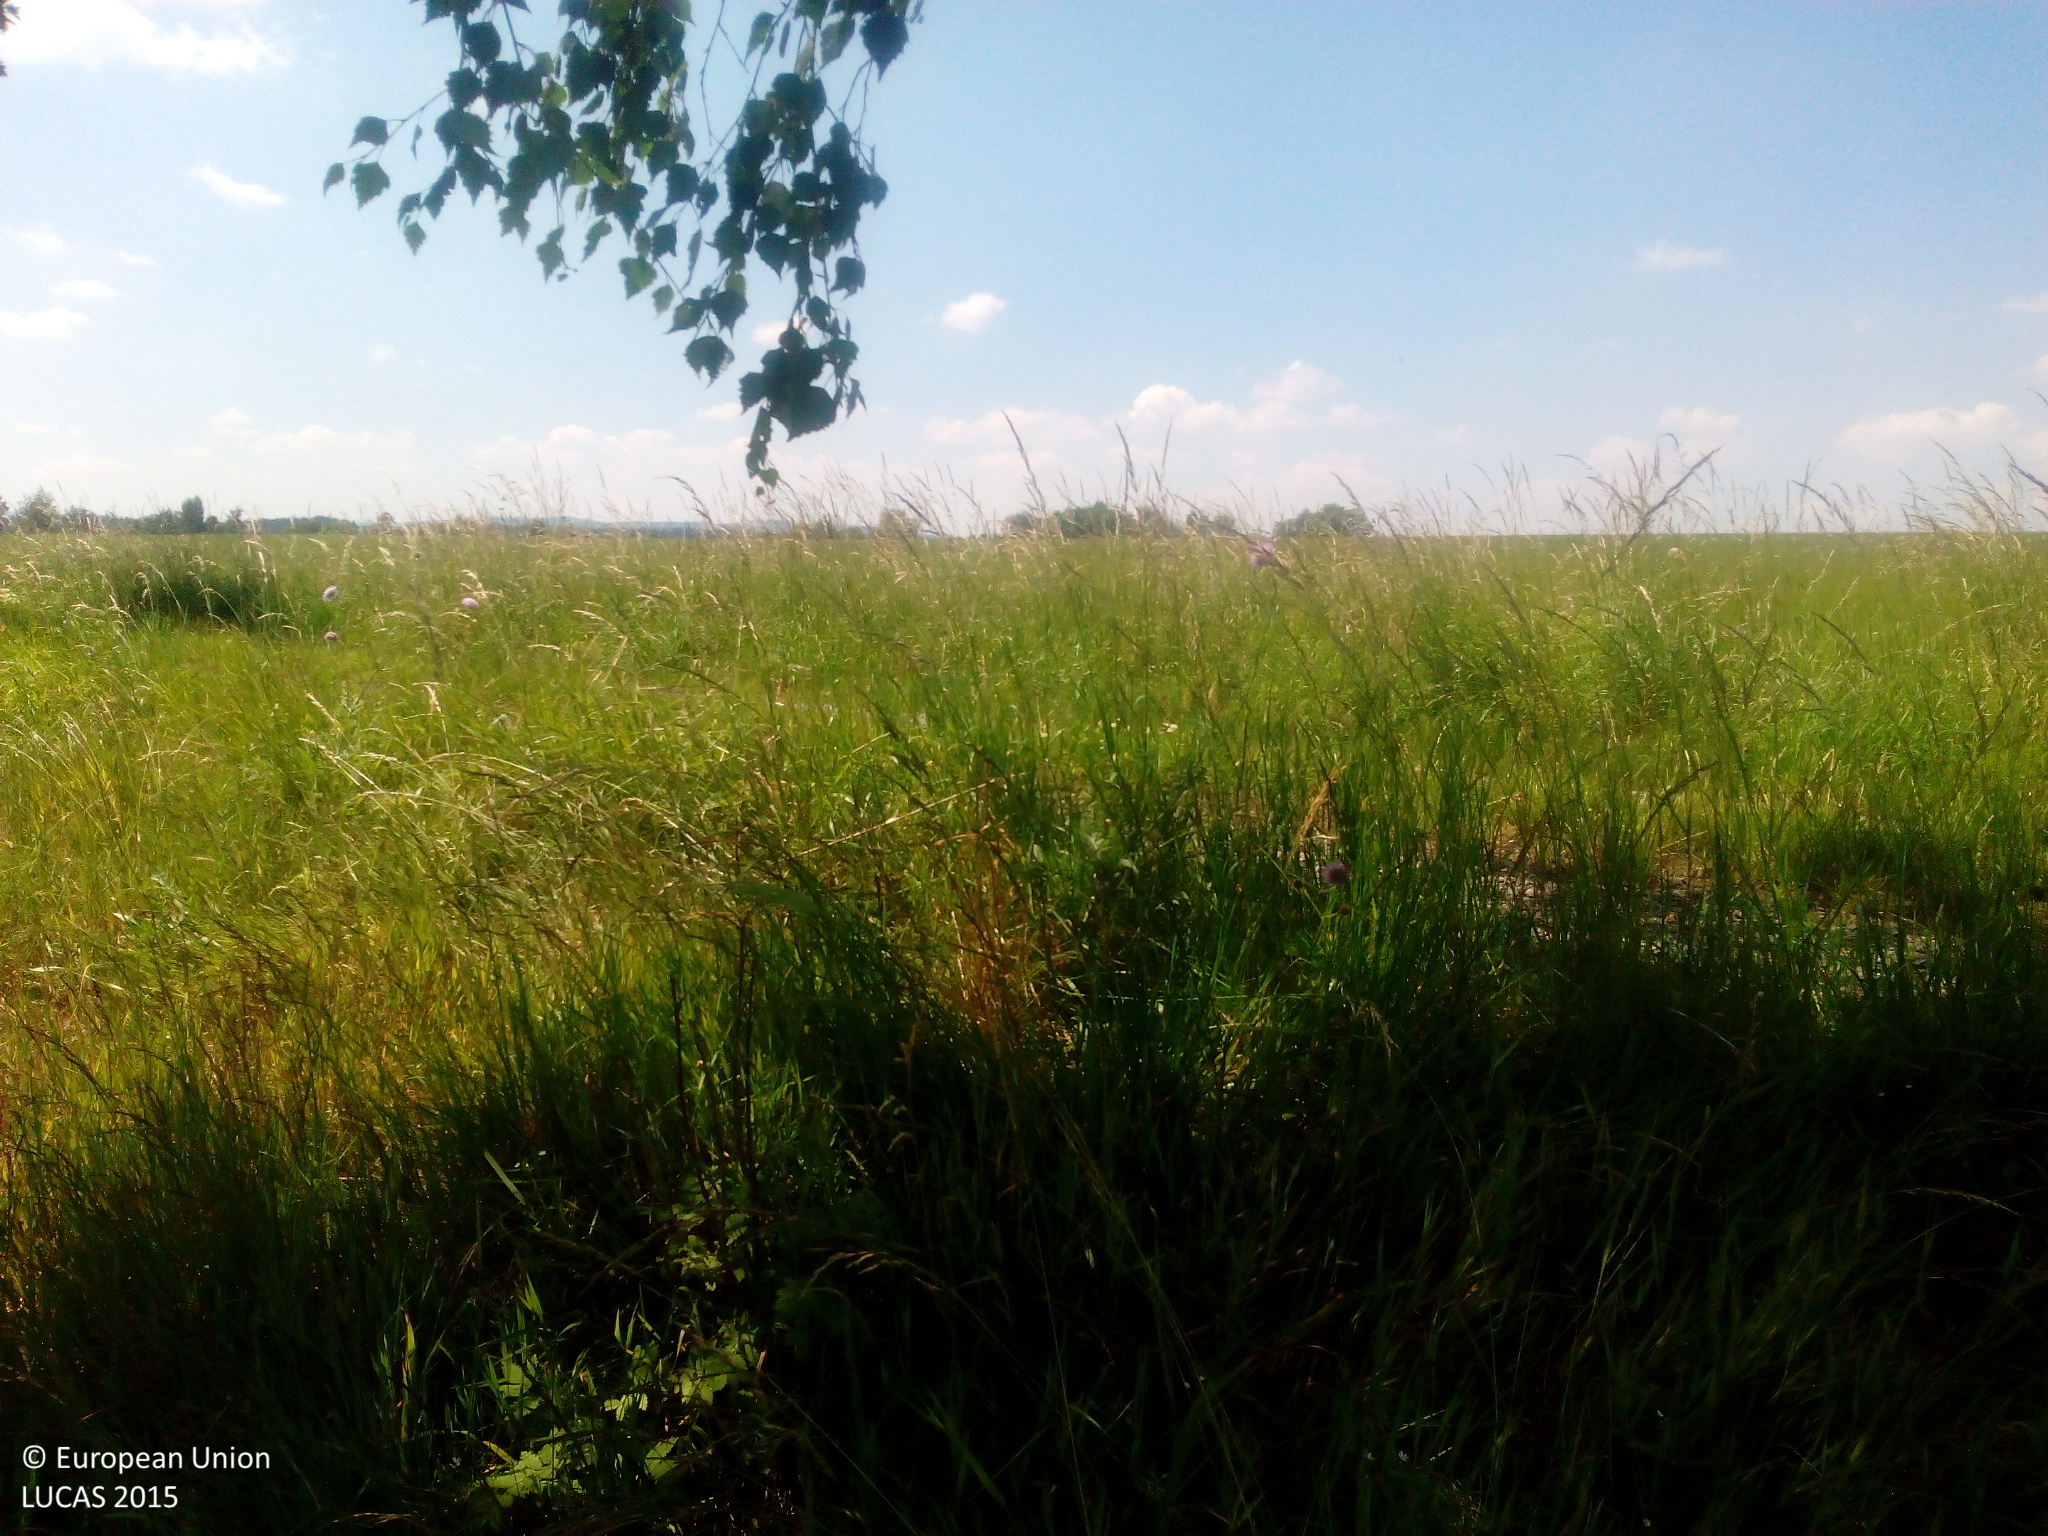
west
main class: Woodland
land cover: Broadleaved woodland
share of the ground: 25 - 50 %
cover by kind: herbaceous plants 75 %, broadleaved forest trees 25 %
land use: Road transport
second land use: Agriculture (excluding fallow land and kitchen gardens)
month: June
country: DE
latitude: 50.1482
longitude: 12.0288
